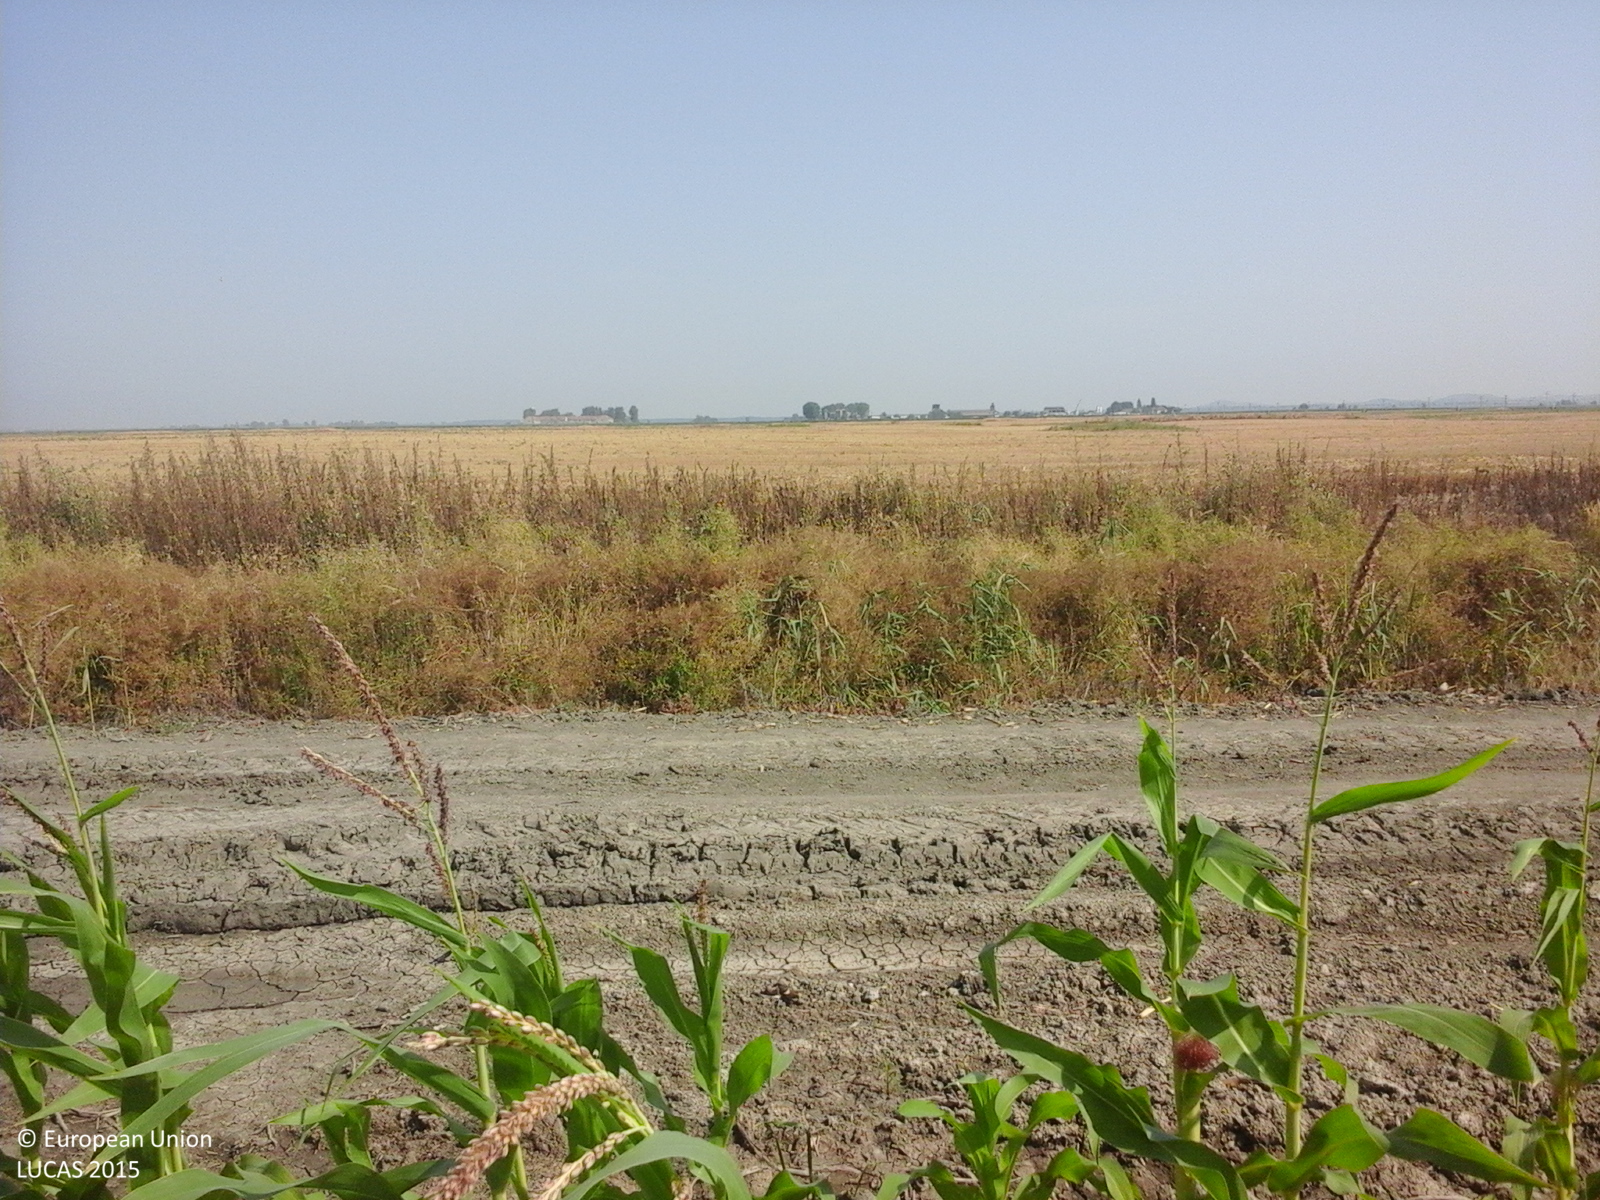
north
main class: Cropland
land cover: Maize
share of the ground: > 75 %
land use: Agriculture (excluding fallow land and kitchen gardens)
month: August
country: RO
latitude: 45.1690
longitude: 28.0430
